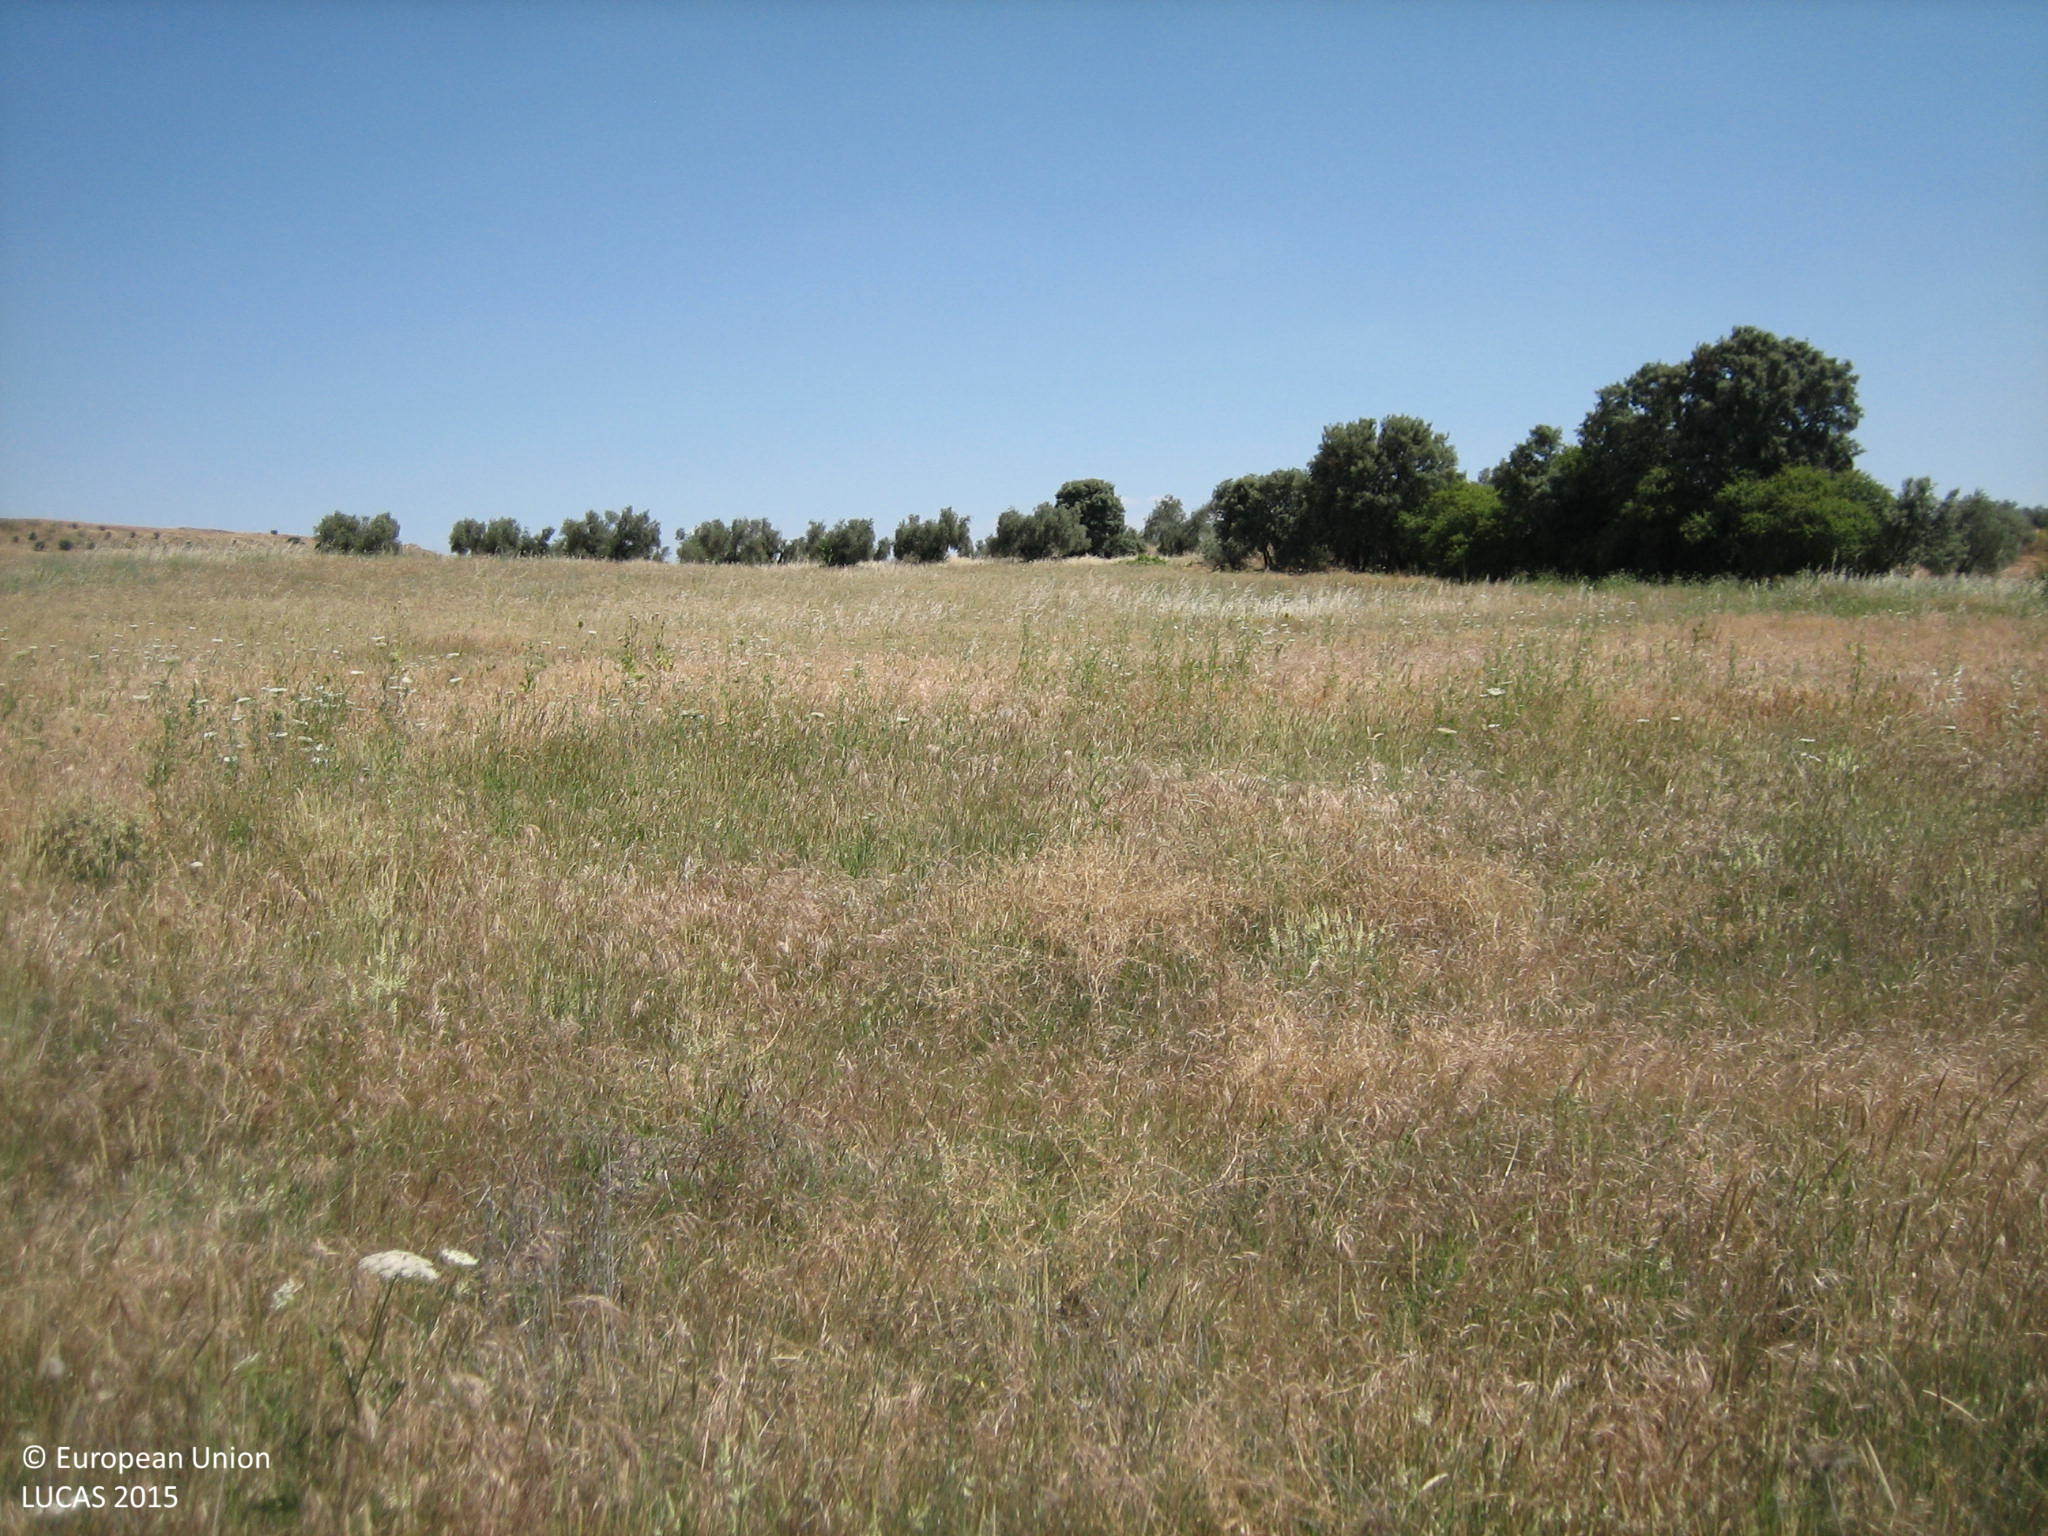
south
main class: Grassland
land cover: Grassland without tree/shrub cover
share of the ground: > 75 %
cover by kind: herbaceous plants 100 %
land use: Semi-natural and natural areas not in use
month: June
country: ES
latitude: 38.8739
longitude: -4.1179
